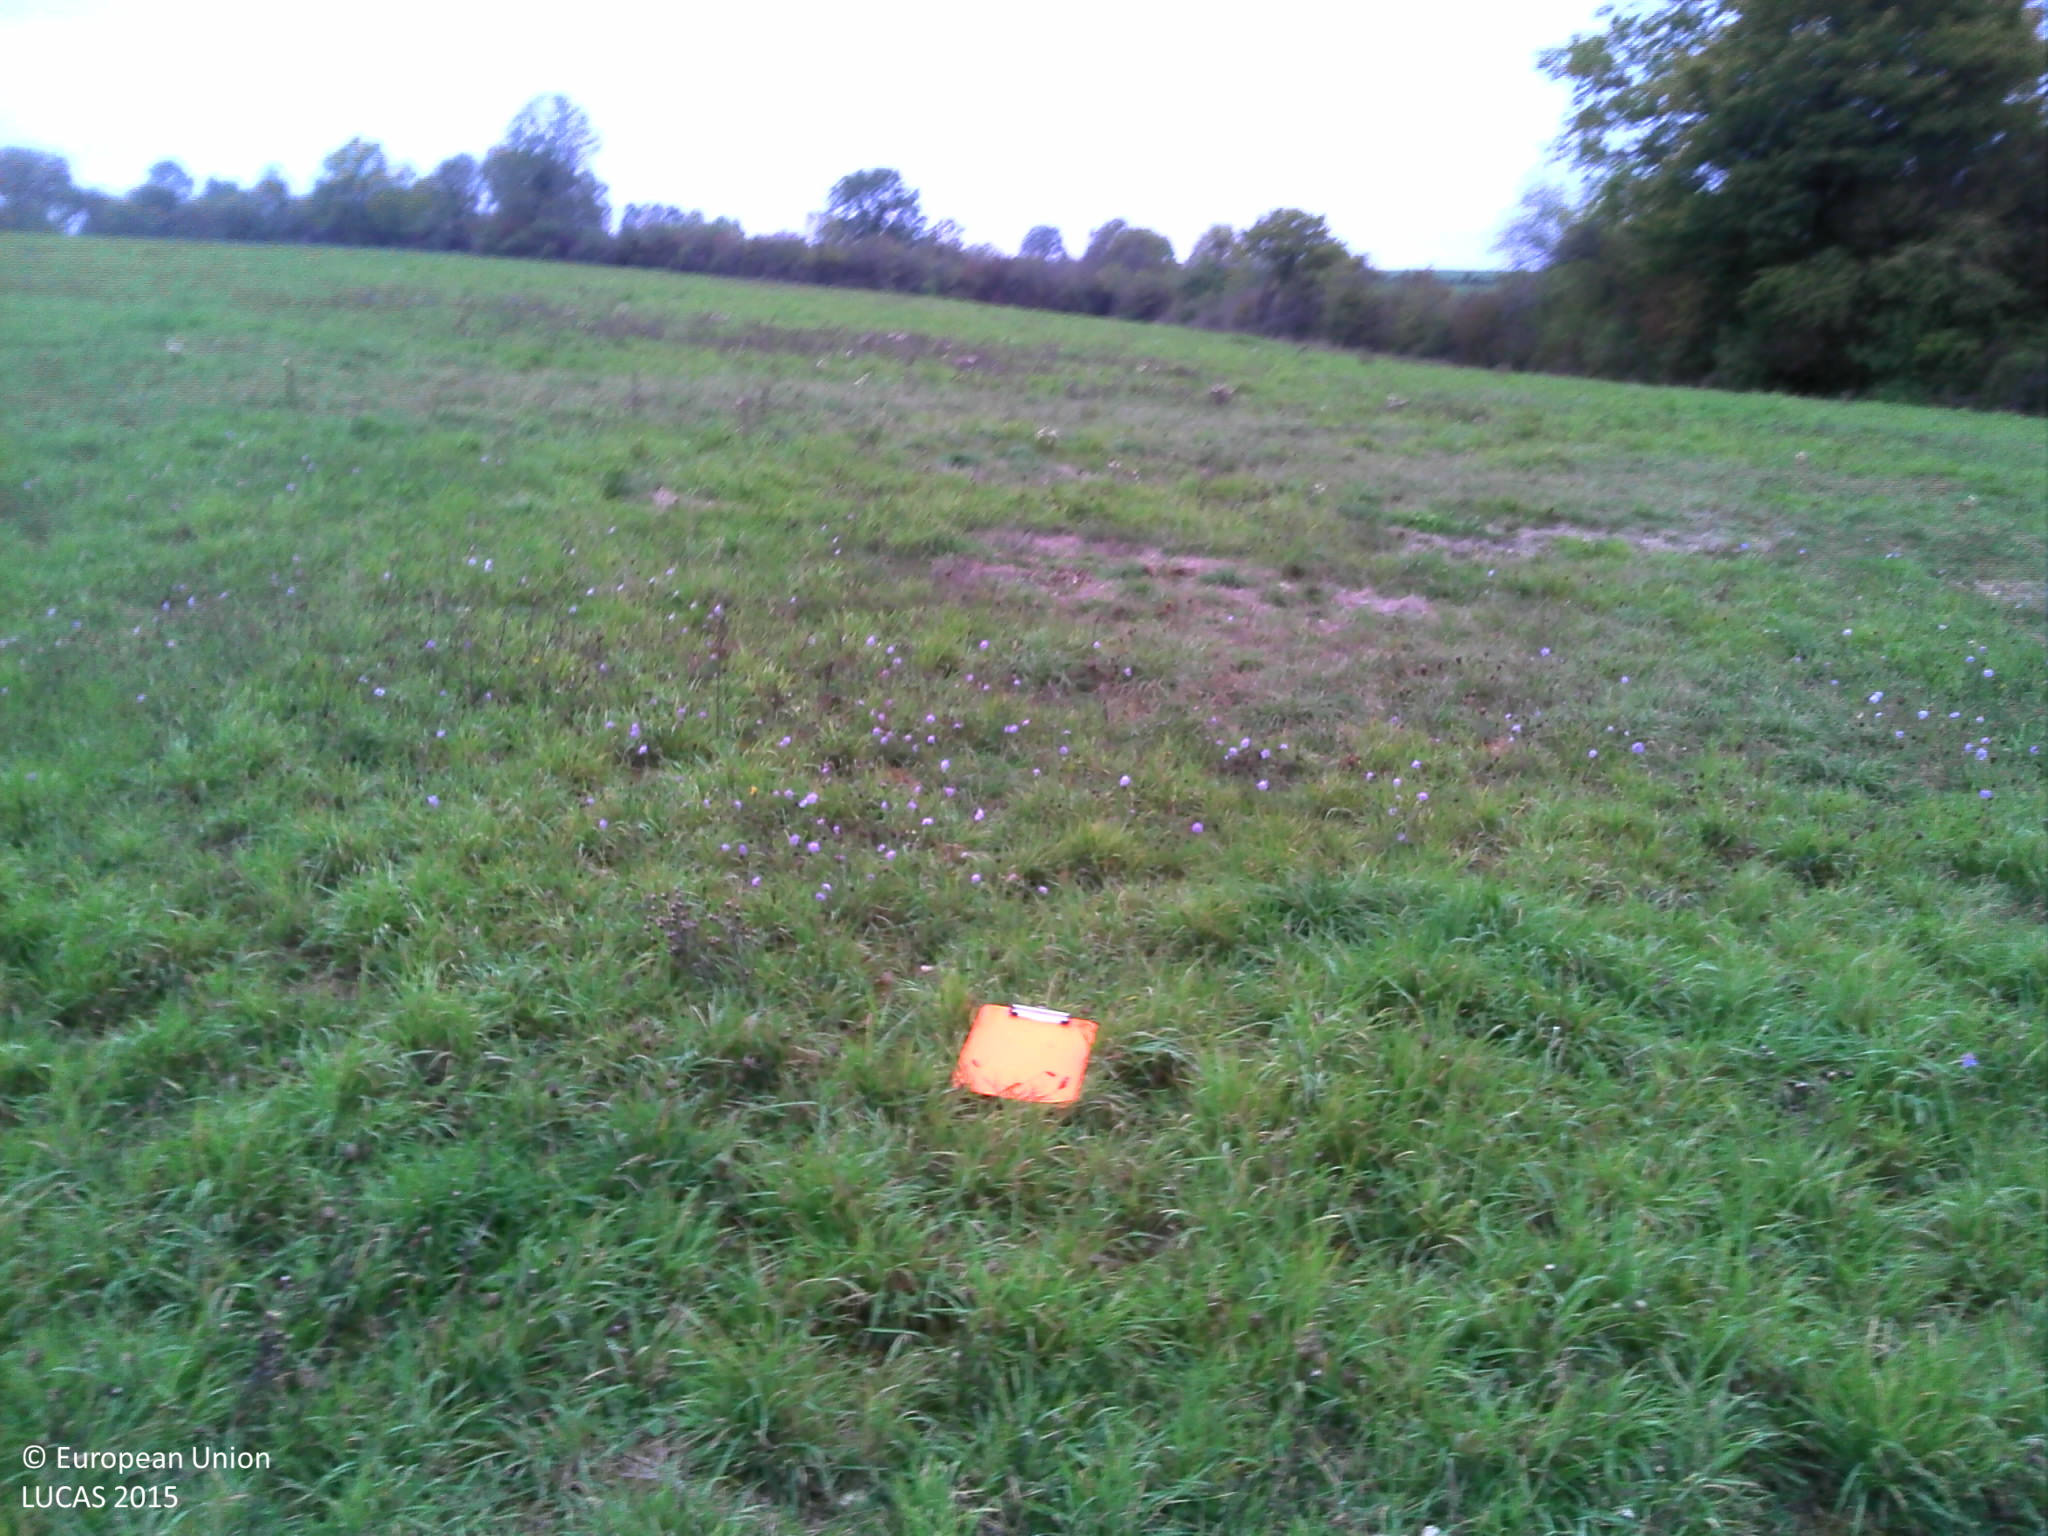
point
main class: Grassland
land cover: Grassland without tree/shrub cover
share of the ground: > 75 %
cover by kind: herbaceous plants 100 %
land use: Agriculture (excluding fallow land and kitchen gardens)
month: October
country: FR
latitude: 47.4560
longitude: 4.8933
